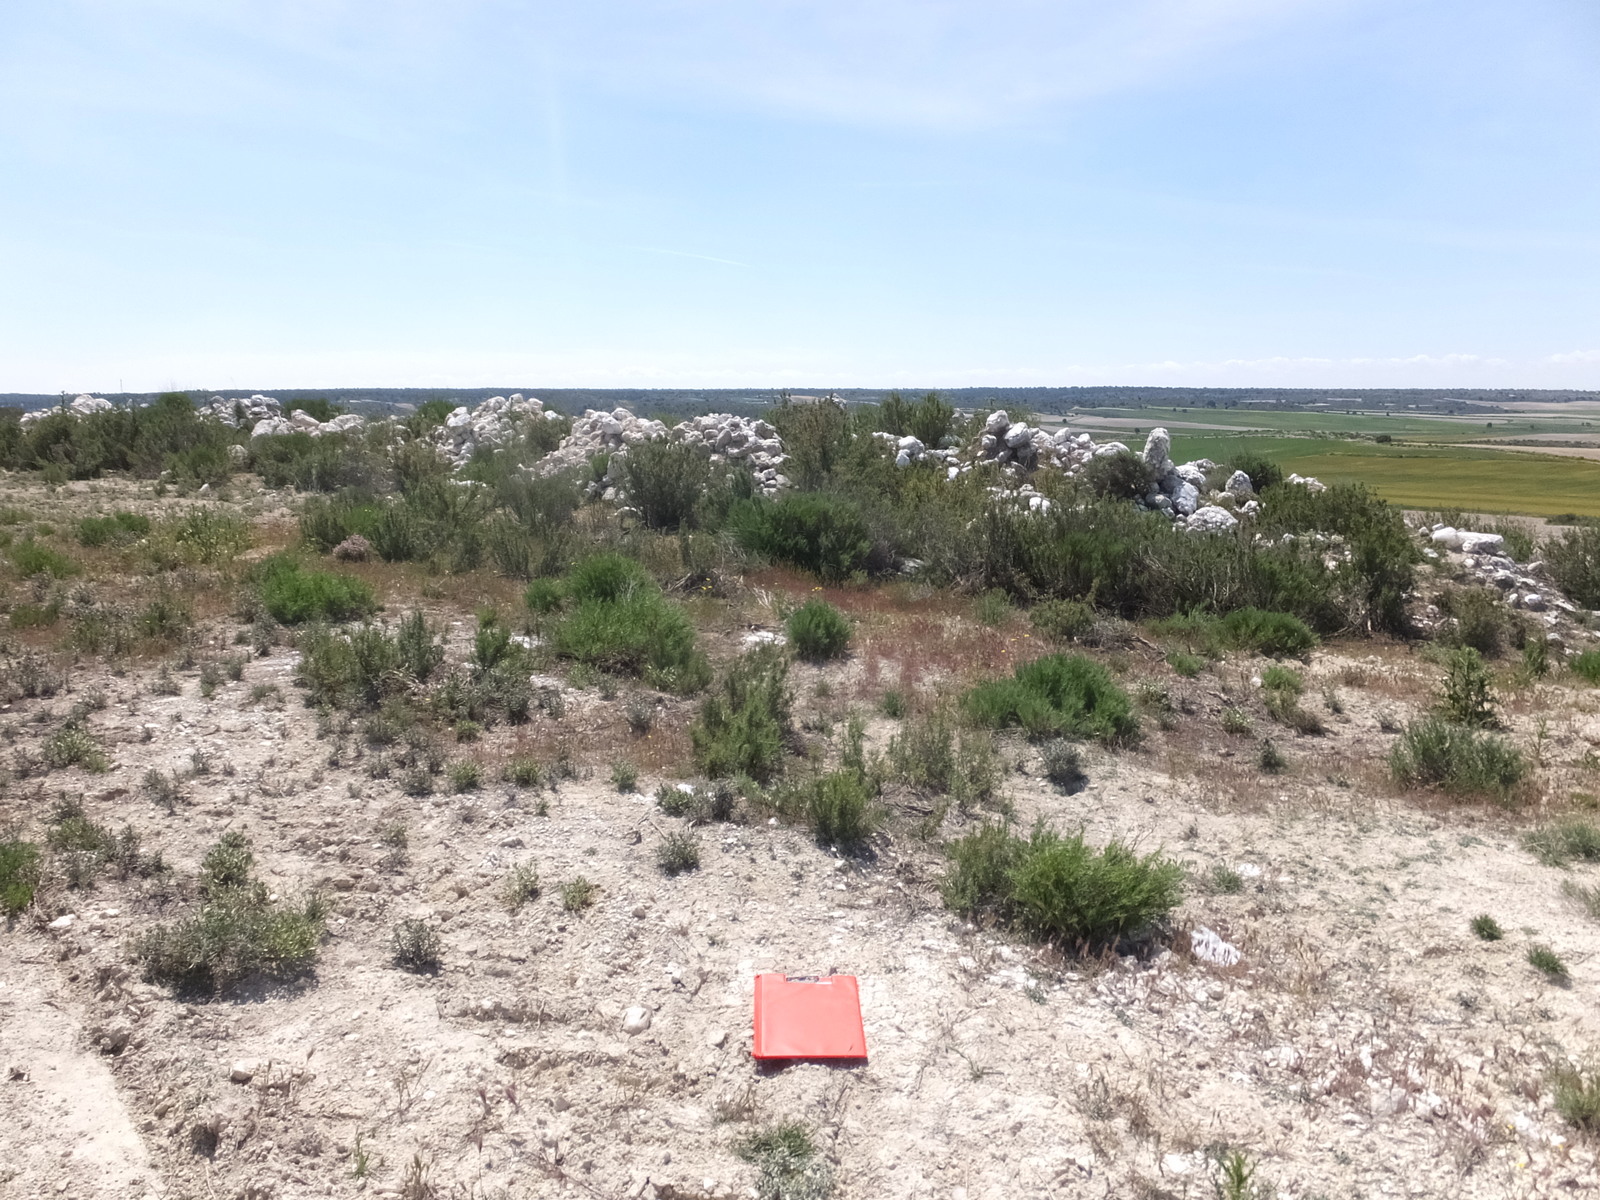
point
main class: Shrubland
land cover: Shrubland without tree cover
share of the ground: > 75 %
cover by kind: shrubs 50 %, herbaceous plants 25 %, consolidated bare surface 25 %
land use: Abandoned areas
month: April
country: ES
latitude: 41.5105
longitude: -0.2844
